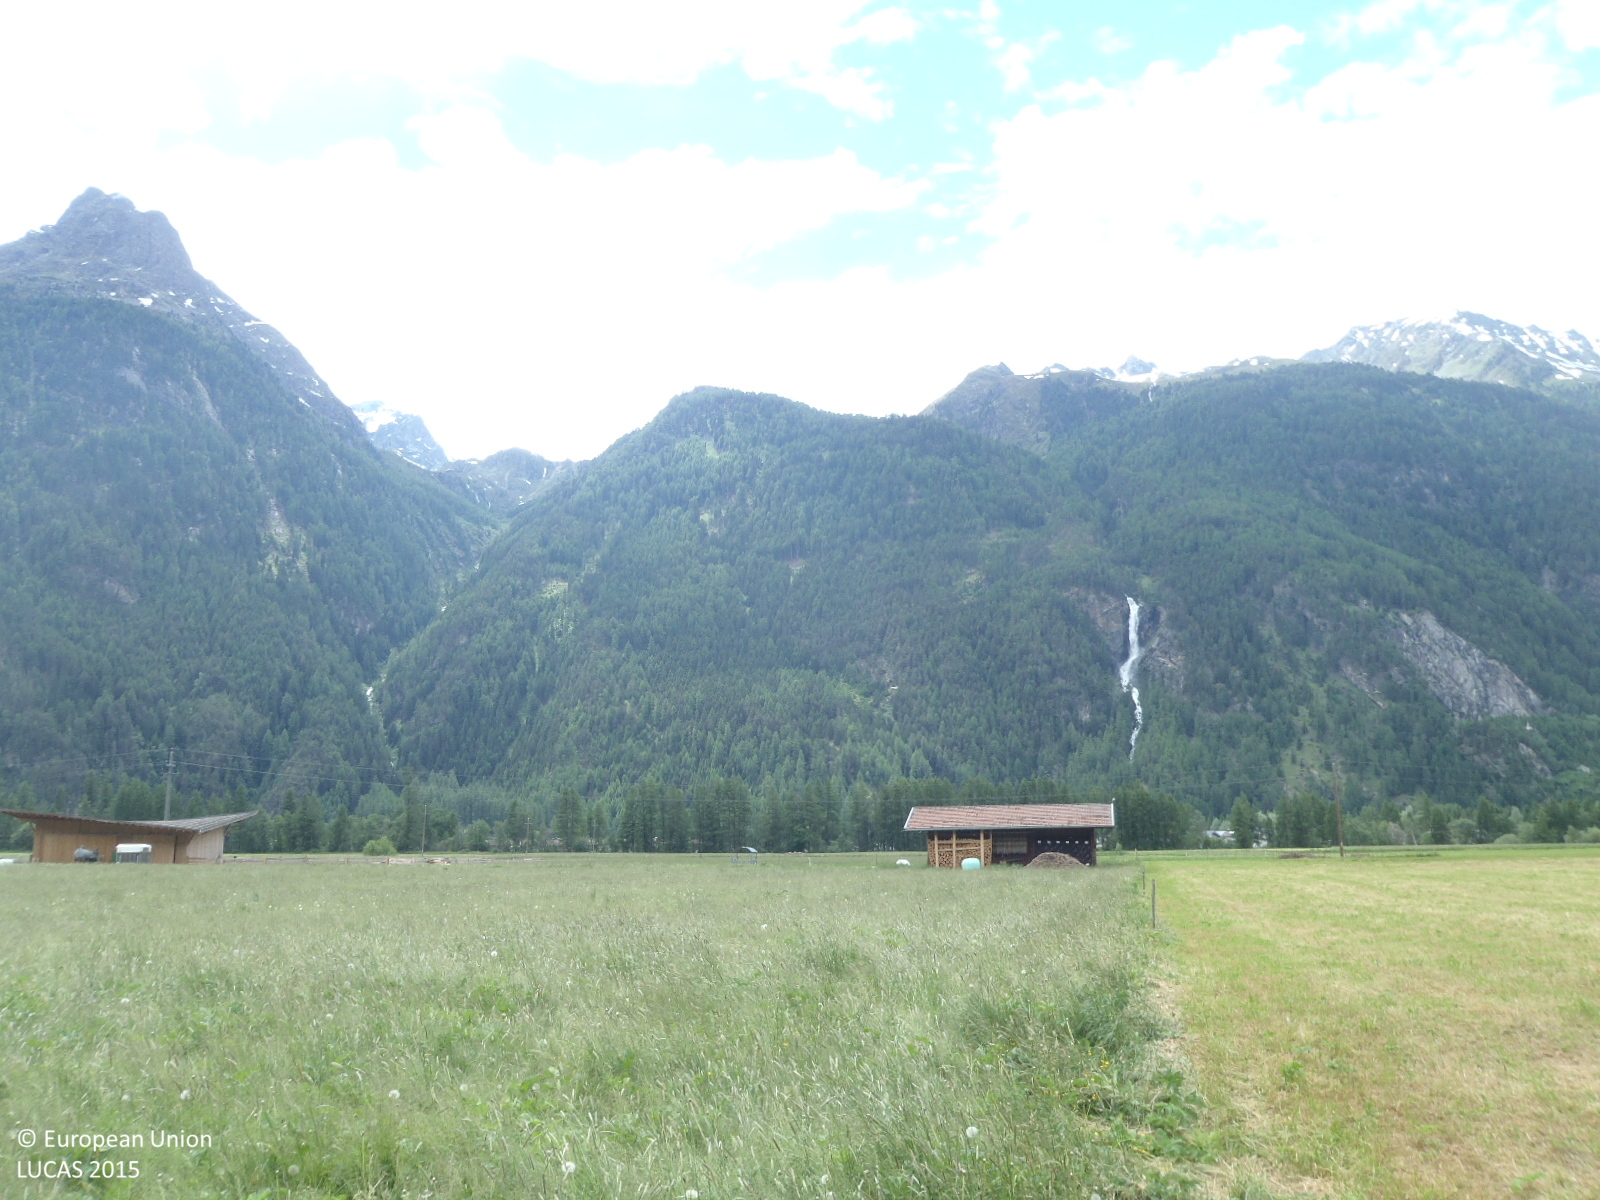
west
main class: Grassland
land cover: Grassland without tree/shrub cover
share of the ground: > 75 %
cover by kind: herbaceous plants 100 %
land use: Agriculture (excluding fallow land and kitchen gardens)
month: June
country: AT
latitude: 47.0853
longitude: 10.9606
